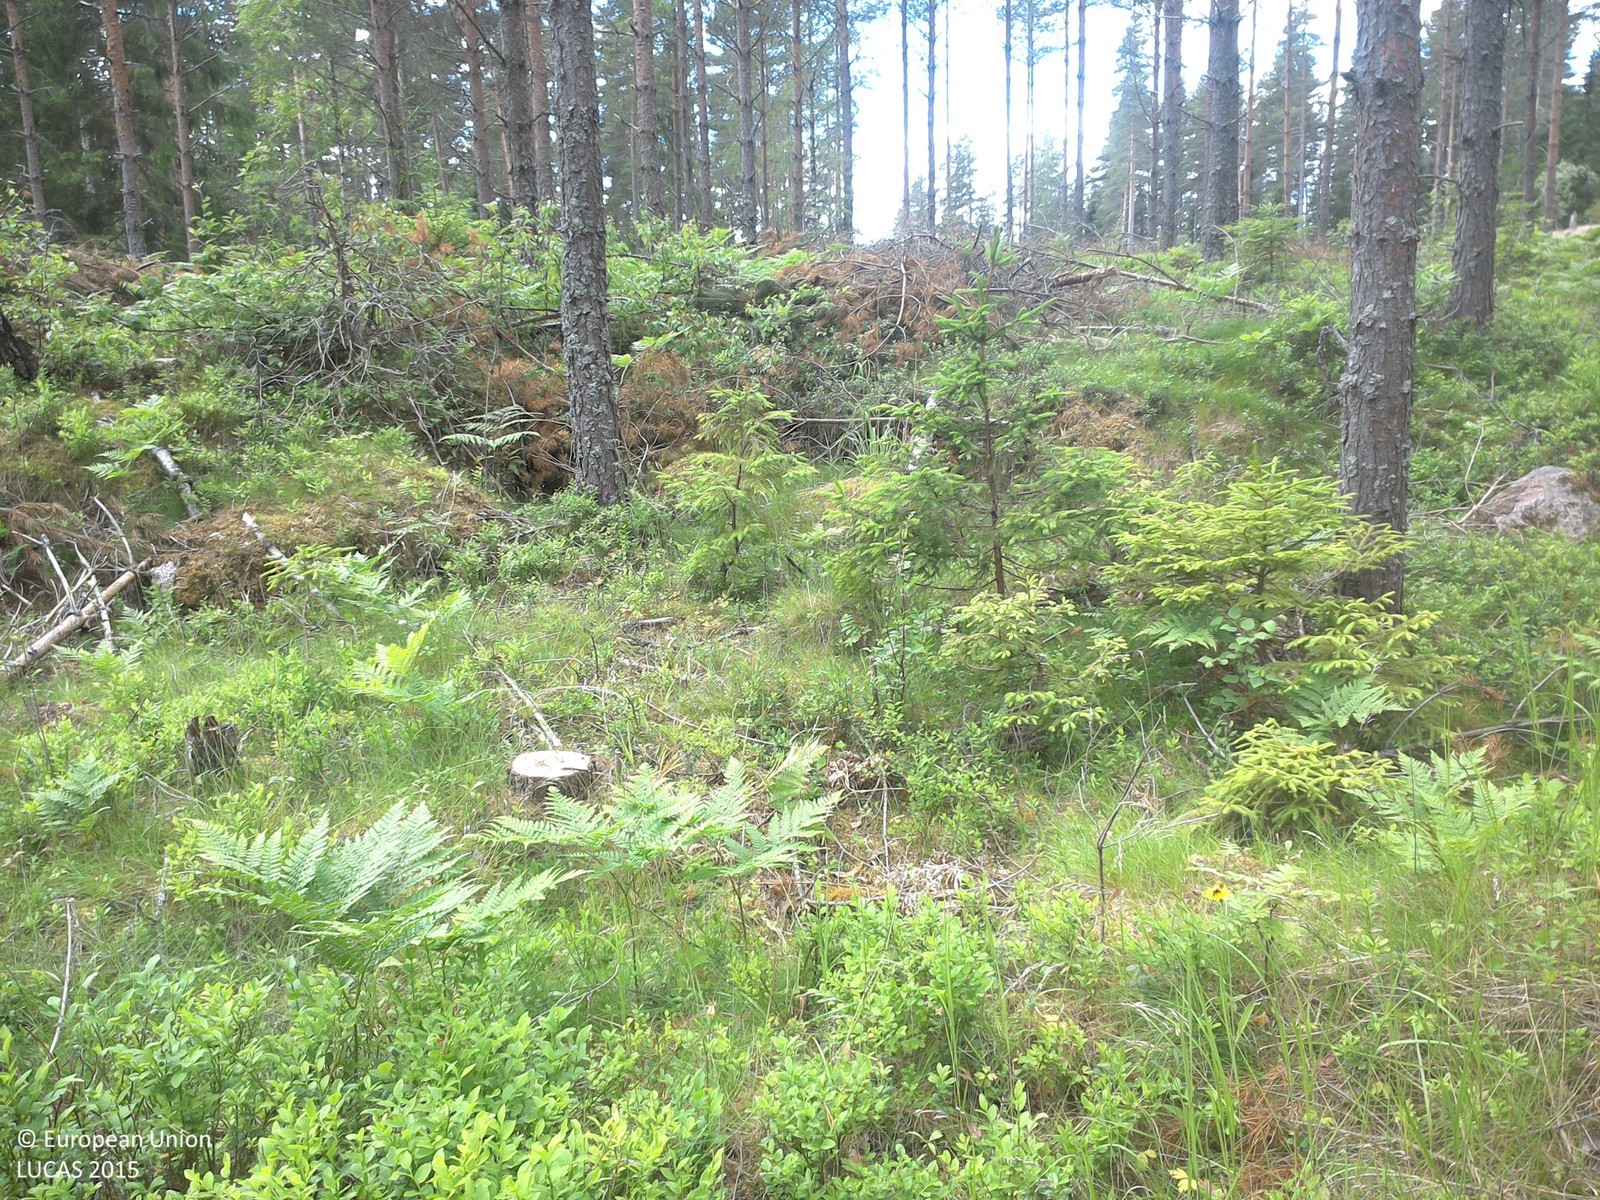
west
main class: Woodland
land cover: Pine dominated coniferous woodland
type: boreal forest
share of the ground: 50 - 75 %
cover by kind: coniferous forest trees 65 %, herbaceous plants 30 %, lichens and mosses 5 %
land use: Forestry
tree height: > 5 m
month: June
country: SE
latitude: 57.9774
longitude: 15.9991
